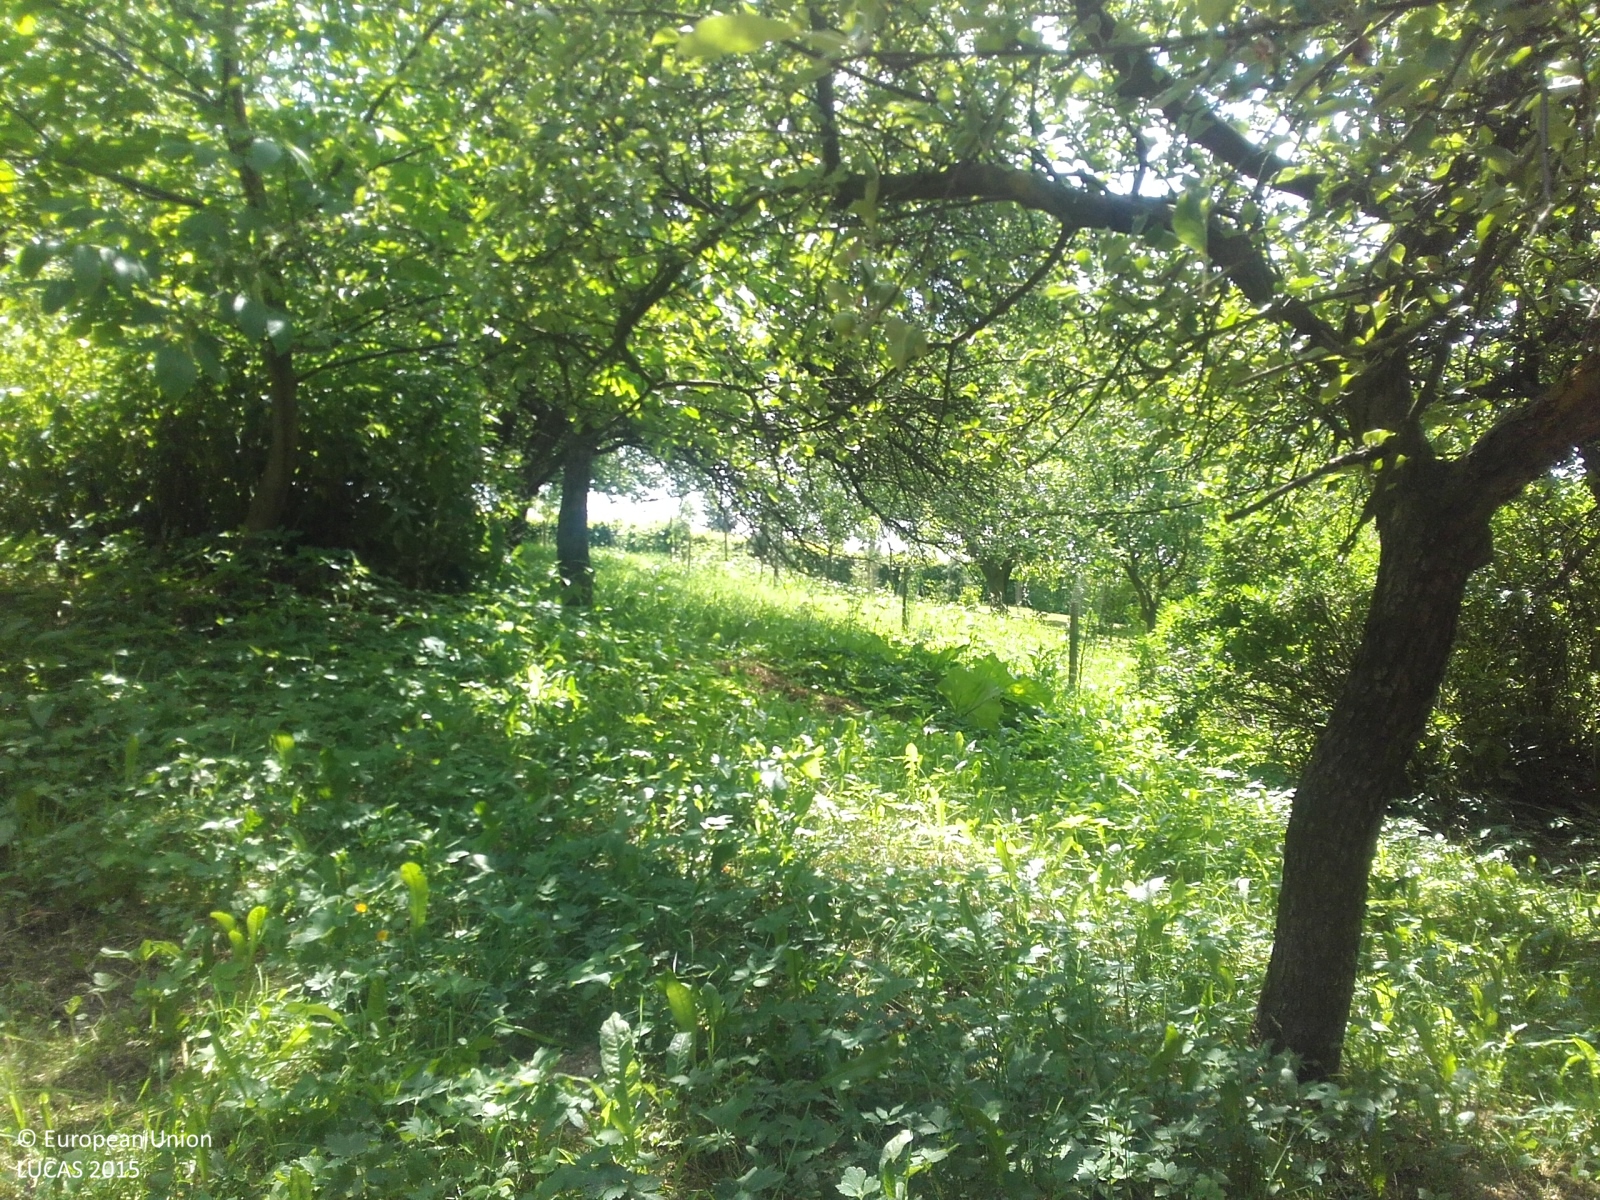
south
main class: Cropland
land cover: Apple fruit
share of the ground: > 75 %
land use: Kitchen garden
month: June
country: CZ
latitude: 49.5762
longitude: 18.7468
